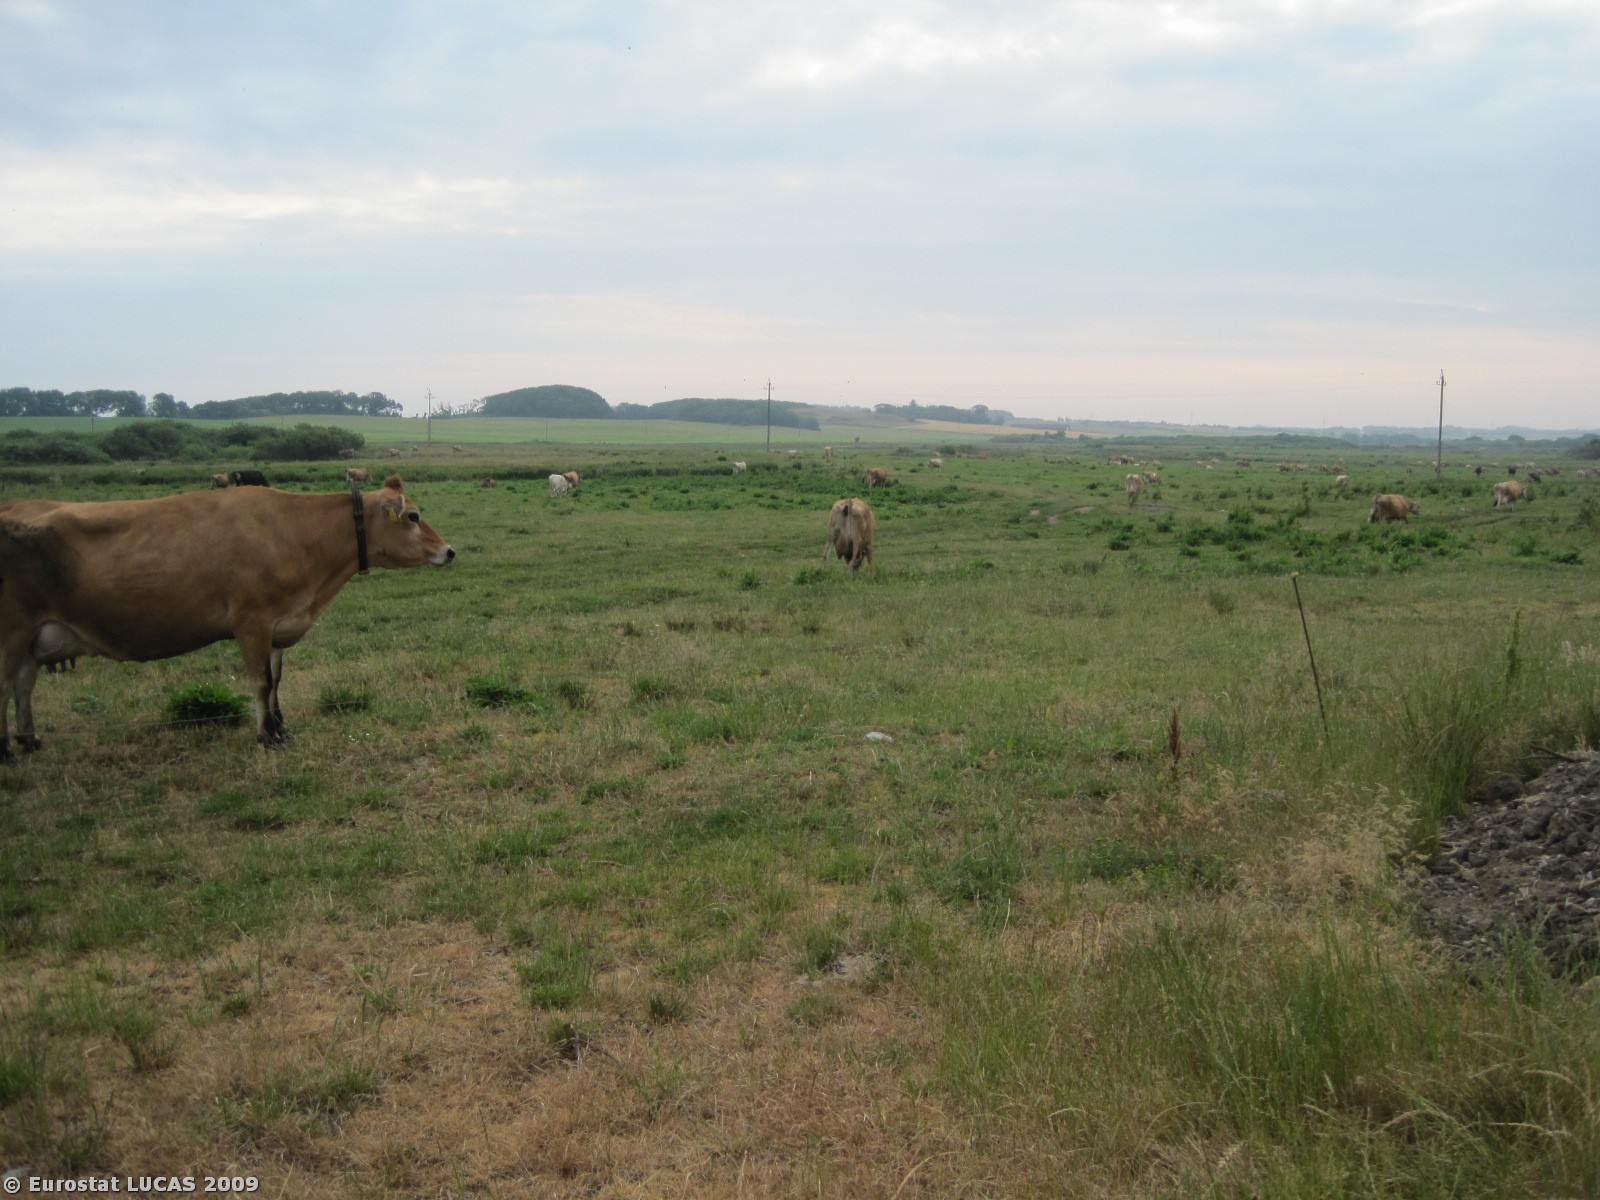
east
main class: Grassland
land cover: Grassland without tree/shrub cover
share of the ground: > 75 %
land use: Agriculture (excluding fallow land and kitchen gardens)
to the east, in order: Grassland without tree/shrub cover; Fences; Grassland without tree/shrub cover; Fences; Shrubland without tree cover; Grassland without tree/shrub cover; Fences; Grassland without tree/shrub cover; Electric lines; Grassland without tree/shrub cover
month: June
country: DK
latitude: 56.5385
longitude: 8.4895
